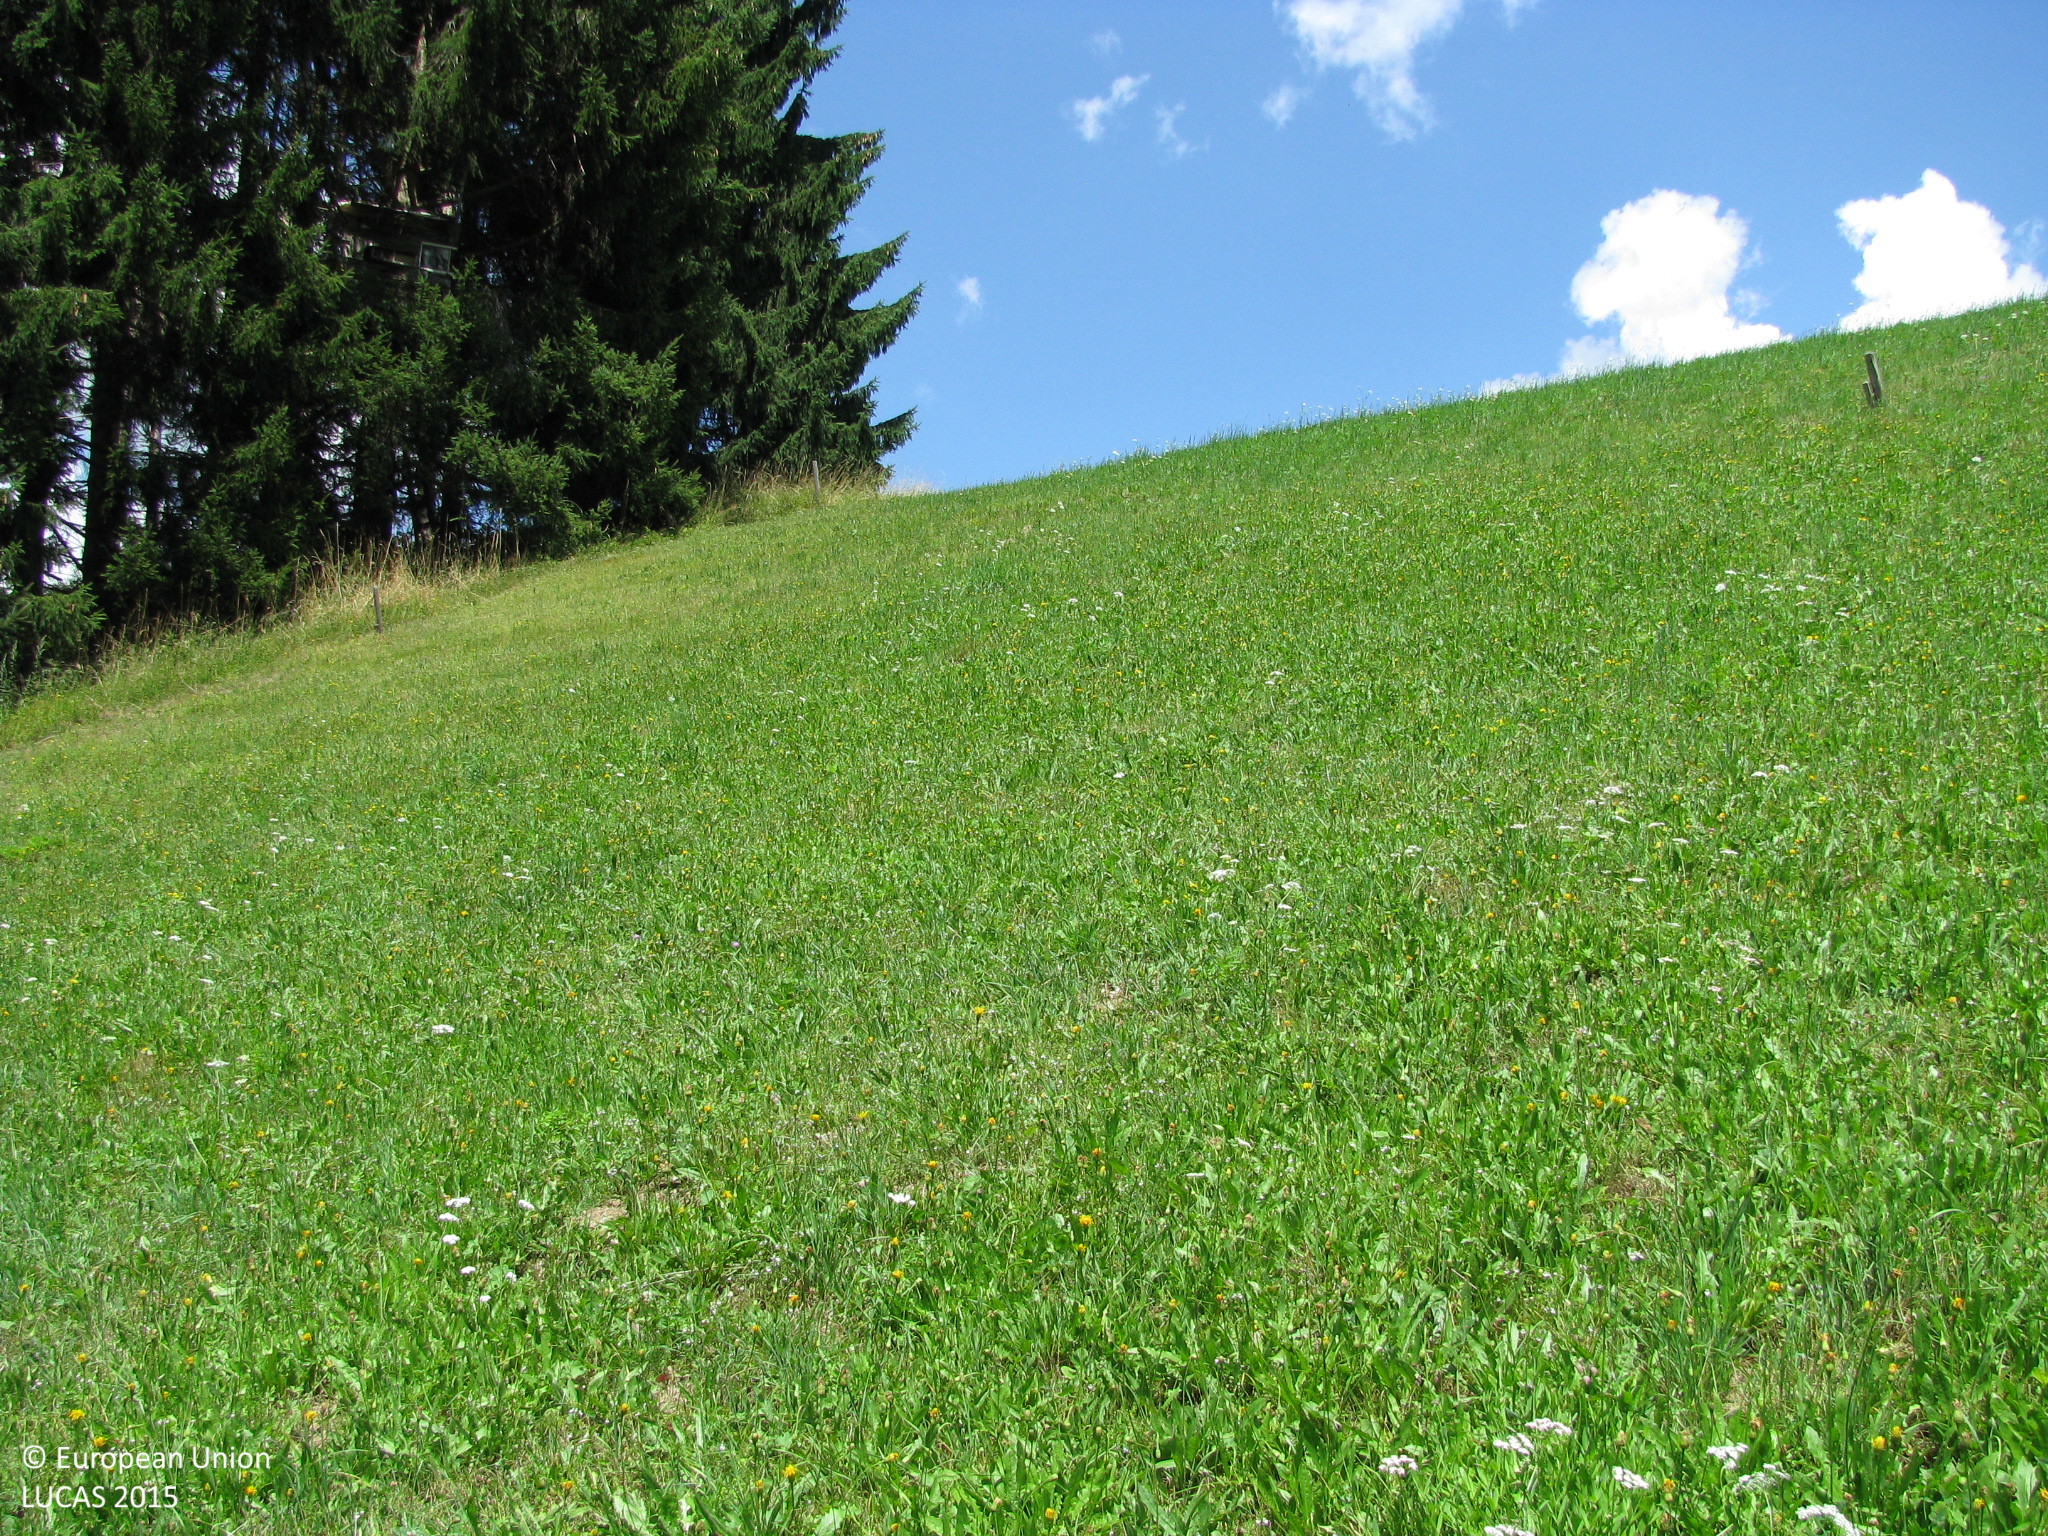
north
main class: Grassland
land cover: Grassland without tree/shrub cover
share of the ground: > 75 %
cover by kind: herbaceous plants 100 %
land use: Agriculture (excluding fallow land and kitchen gardens)
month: July
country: AT
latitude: 46.7371
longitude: 12.4711
